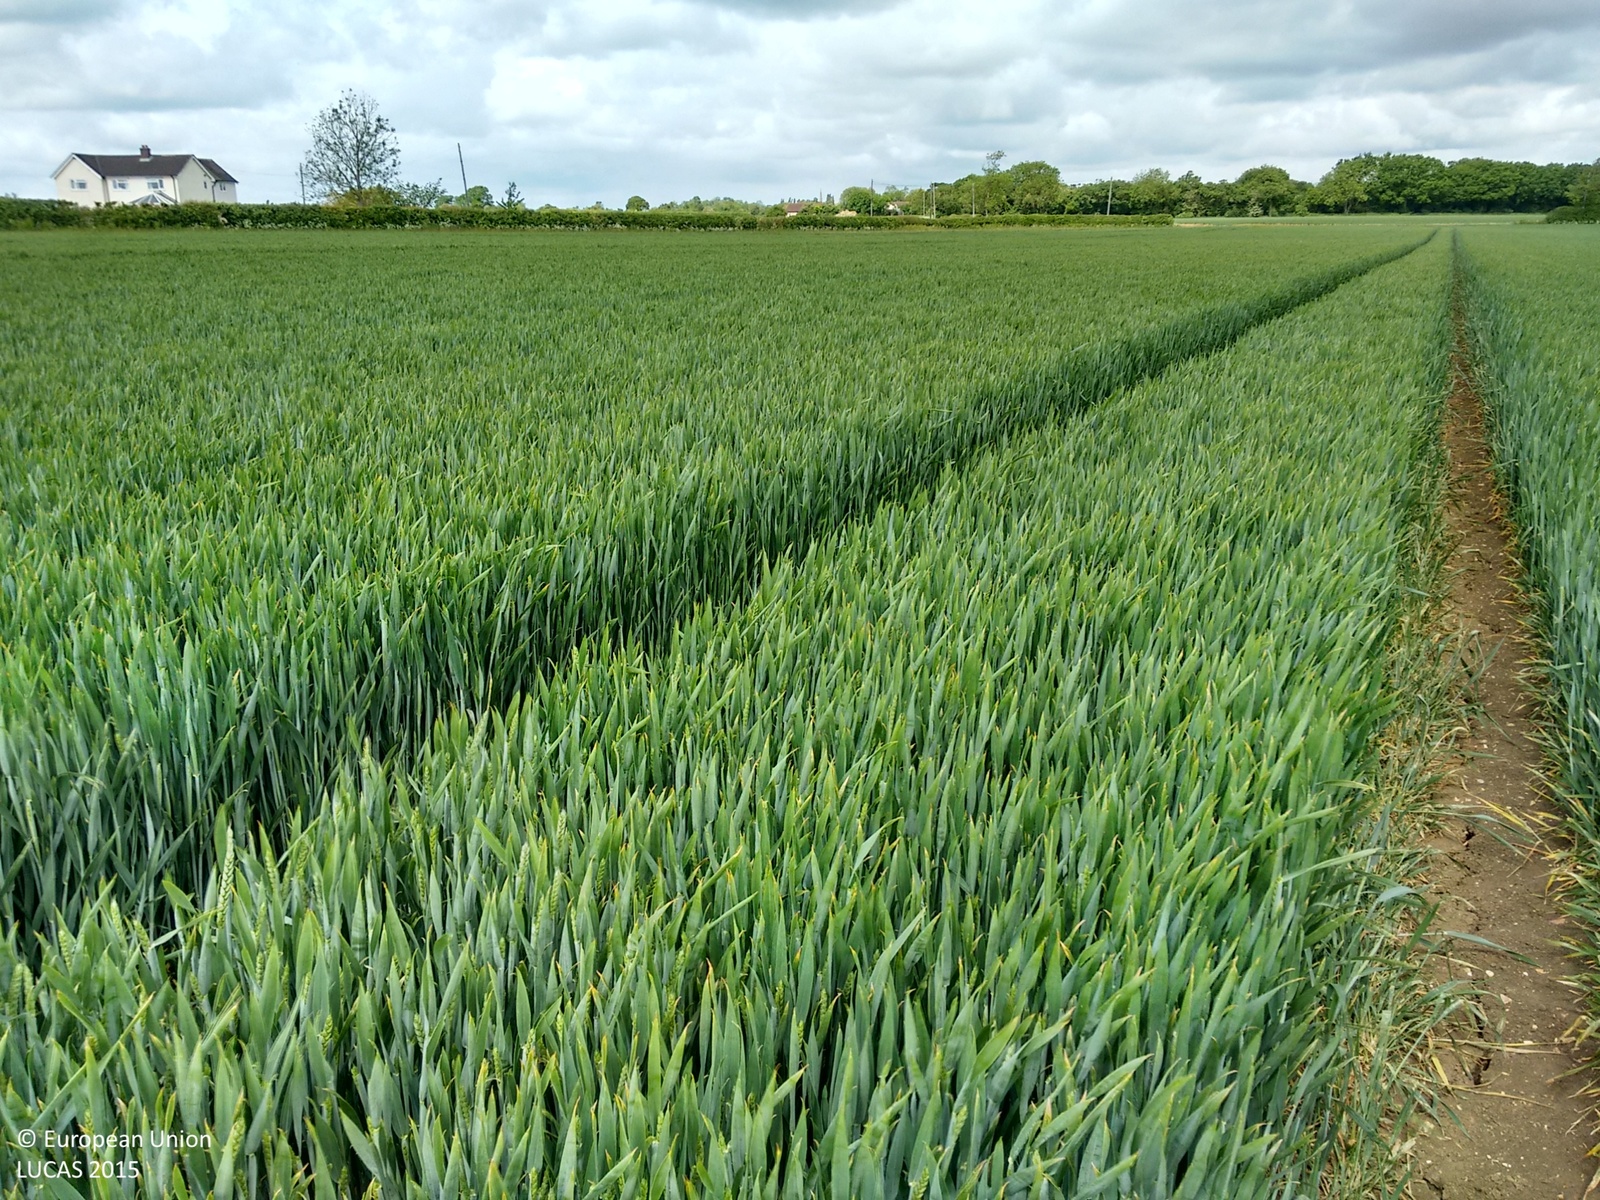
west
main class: Cropland
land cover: Common wheat
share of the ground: > 75 %
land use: Agriculture (excluding fallow land and kitchen gardens)
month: June
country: GB
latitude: 52.2135
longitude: -0.3547
